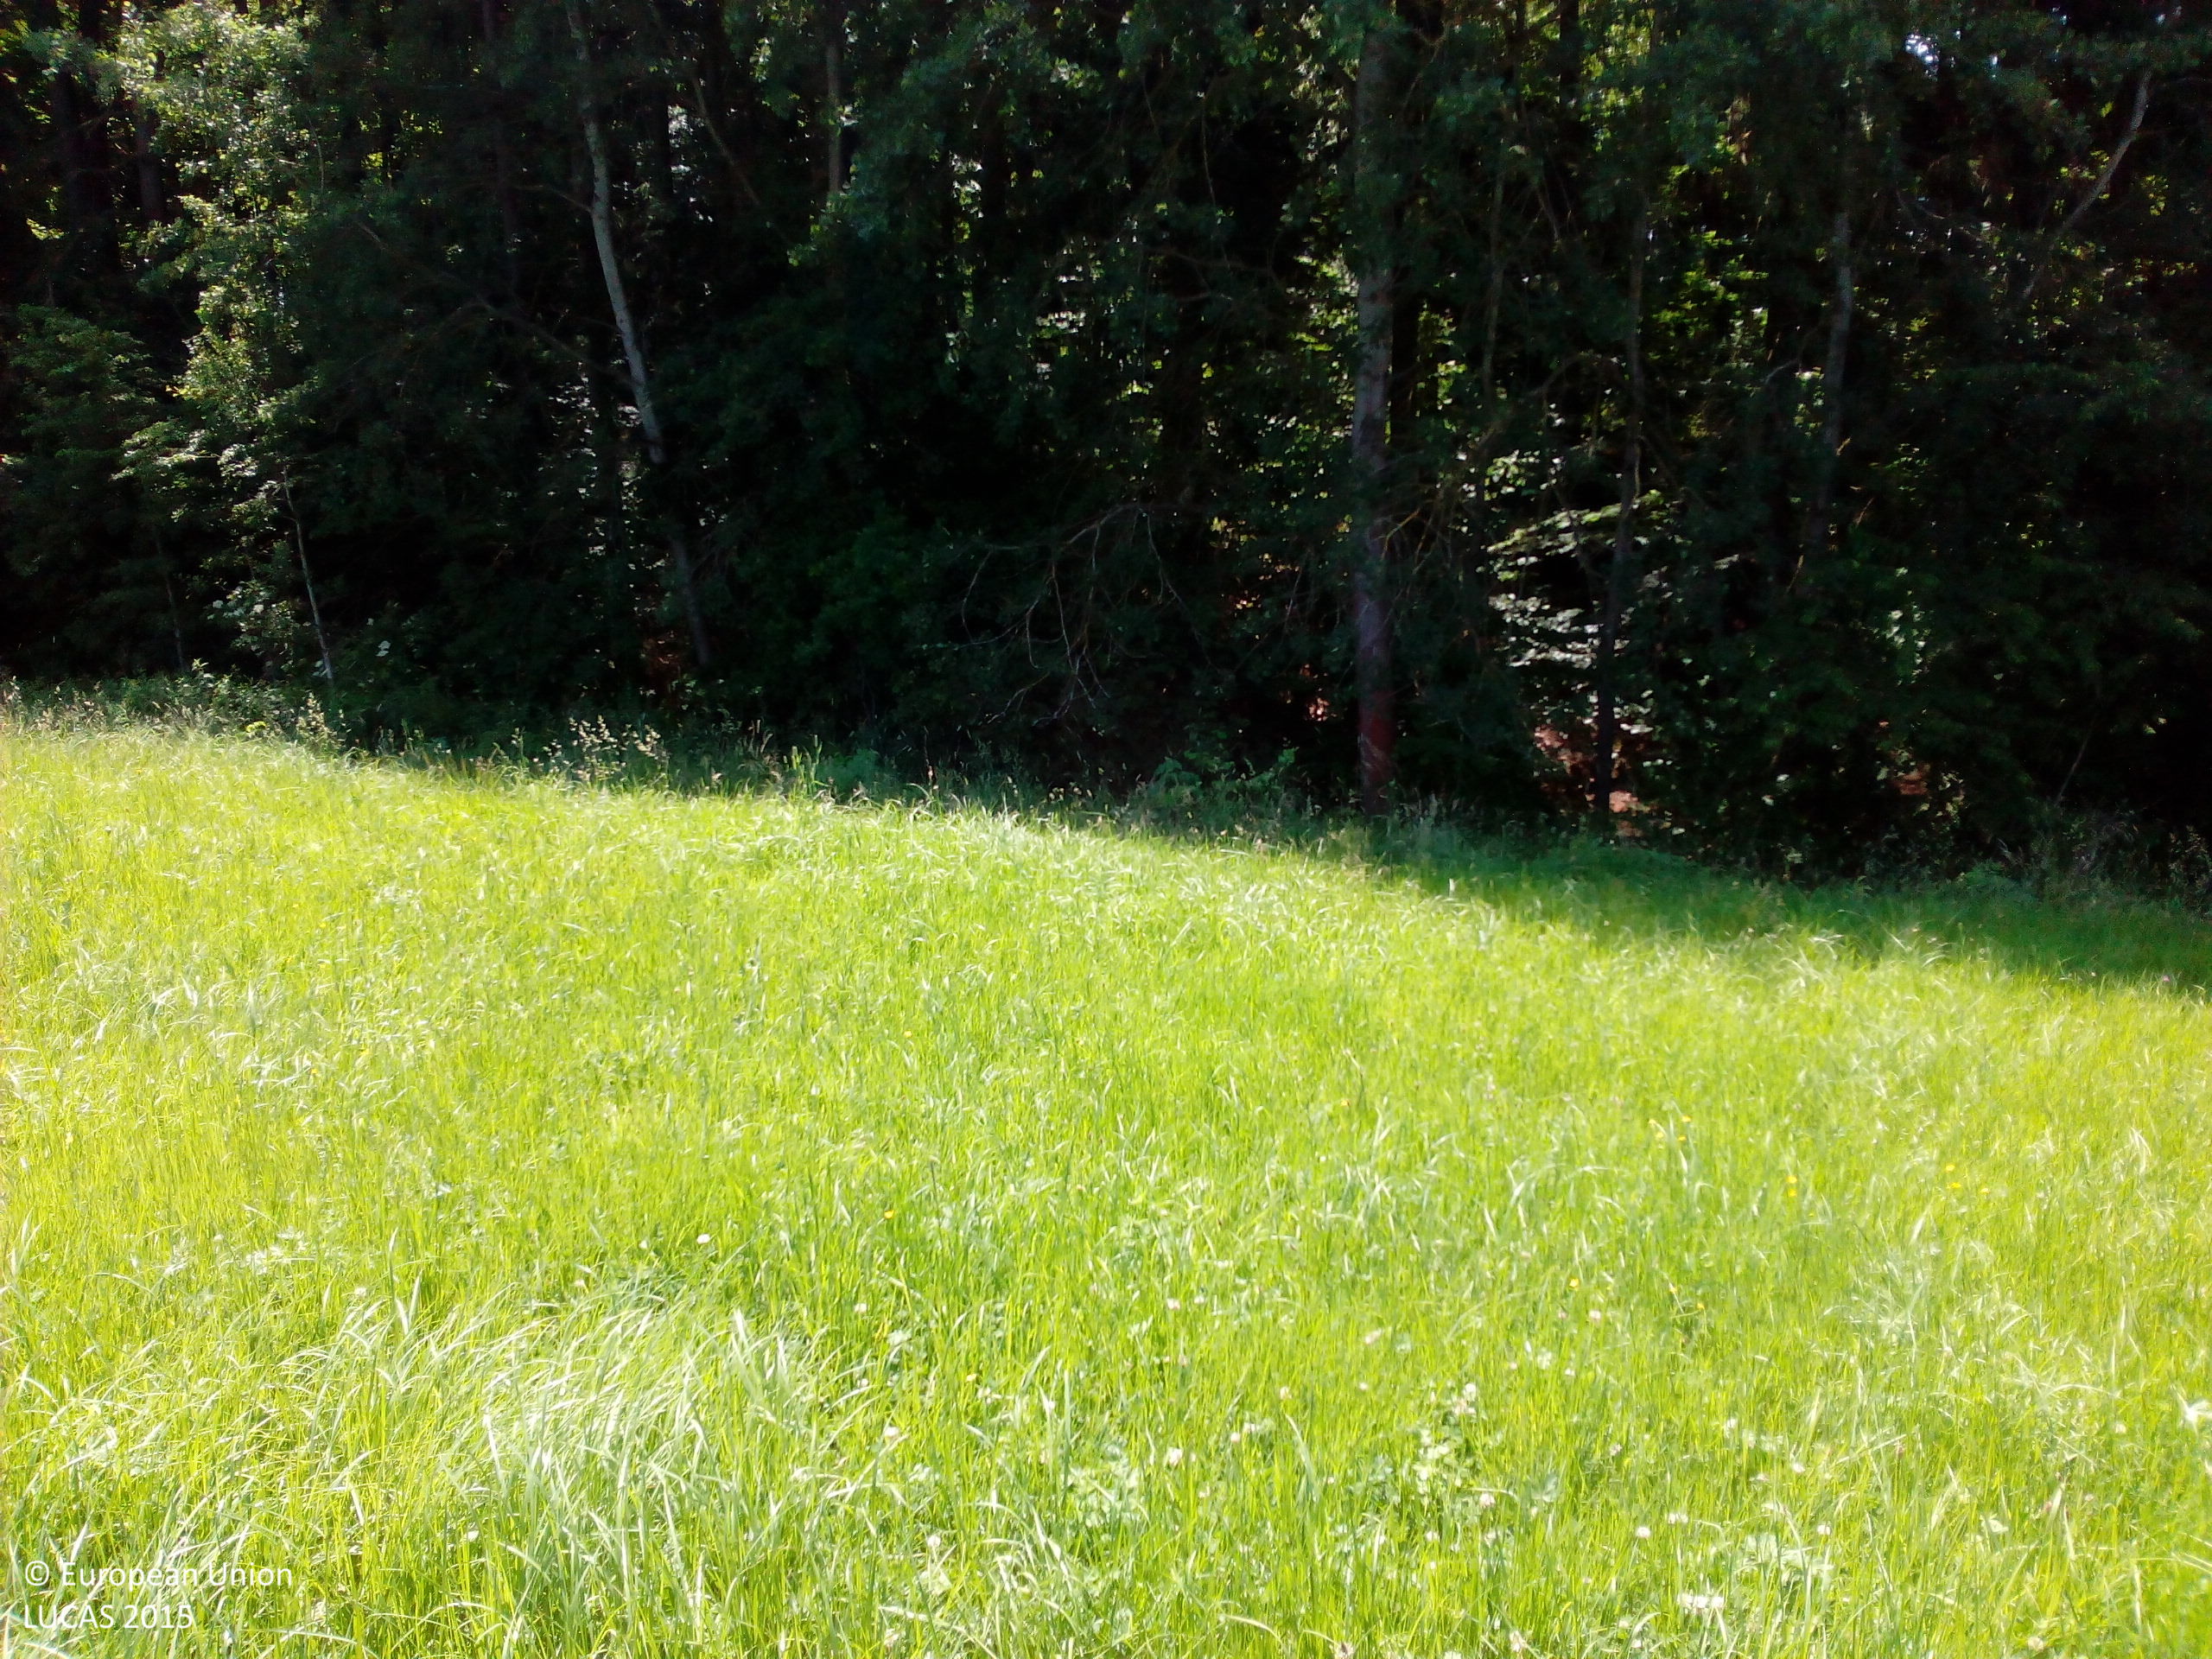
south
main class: Grassland
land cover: Grassland without tree/shrub cover
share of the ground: > 75 %
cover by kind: herbaceous plants 100 %
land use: Agriculture (excluding fallow land and kitchen gardens)
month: June
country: DE
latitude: 49.1688
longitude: 12.4271
